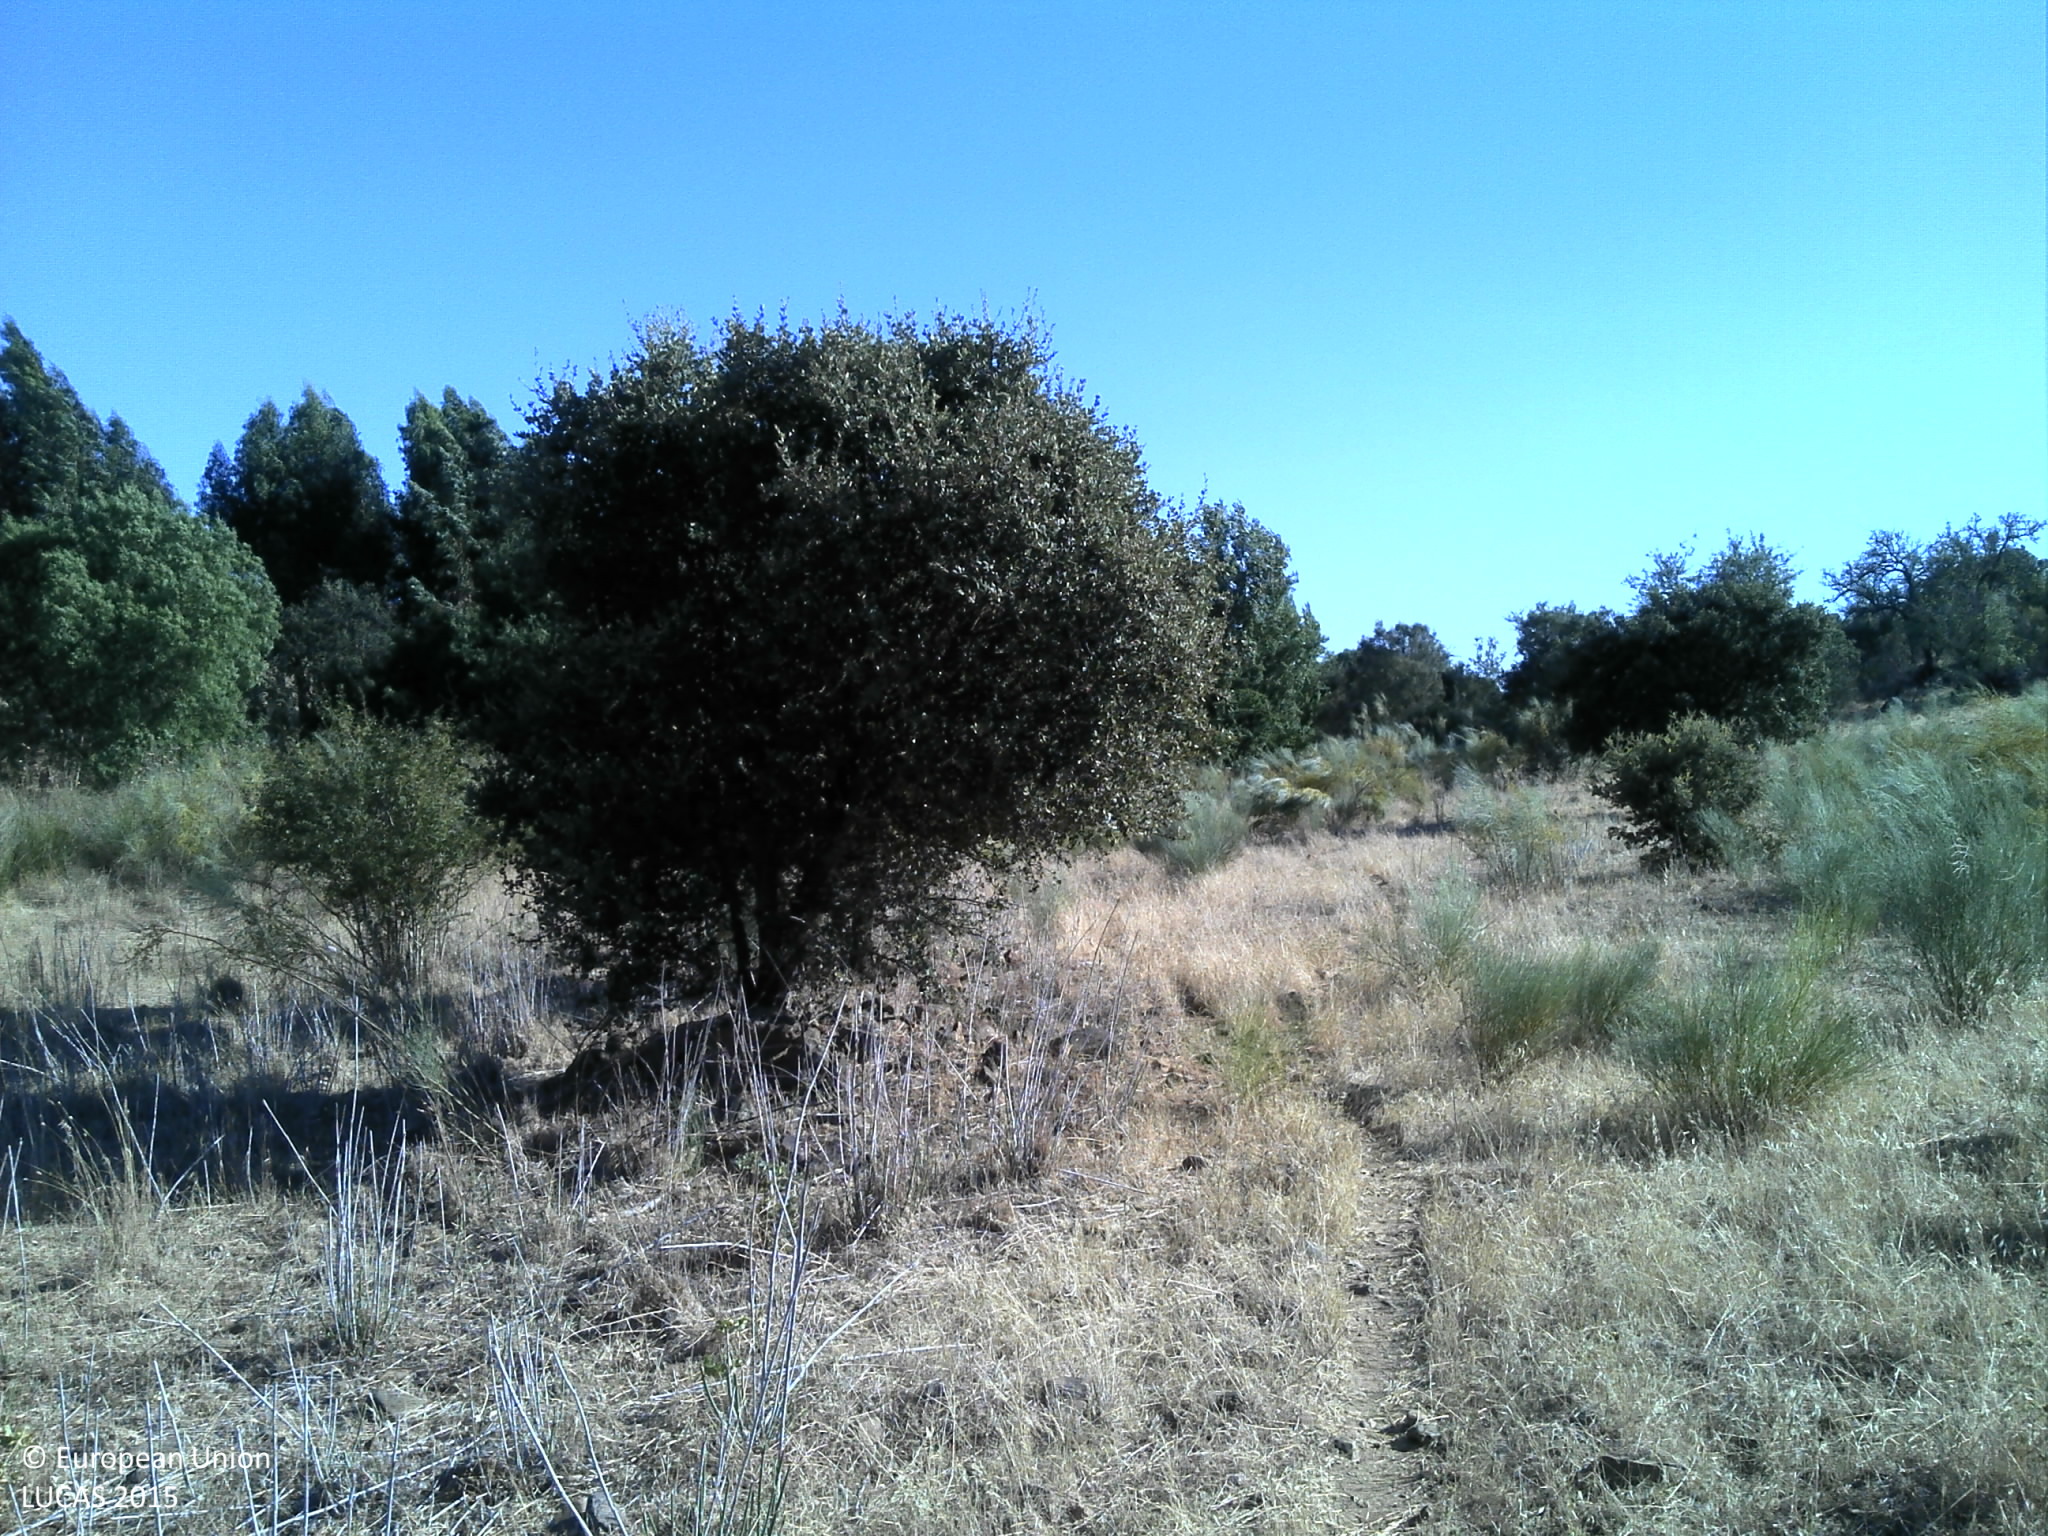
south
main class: Shrubland
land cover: Shrubland with sparse tree cover
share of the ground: 25 - 50 %
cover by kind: unconsolidated bare surface 70 %, shrubs 15 %, herbaceous plants 10 %, broadleaved forest trees 5 %
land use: Agriculture (excluding fallow land and kitchen gardens)
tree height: < 5 m
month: July
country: PT
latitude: 38.9664
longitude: -7.4518
